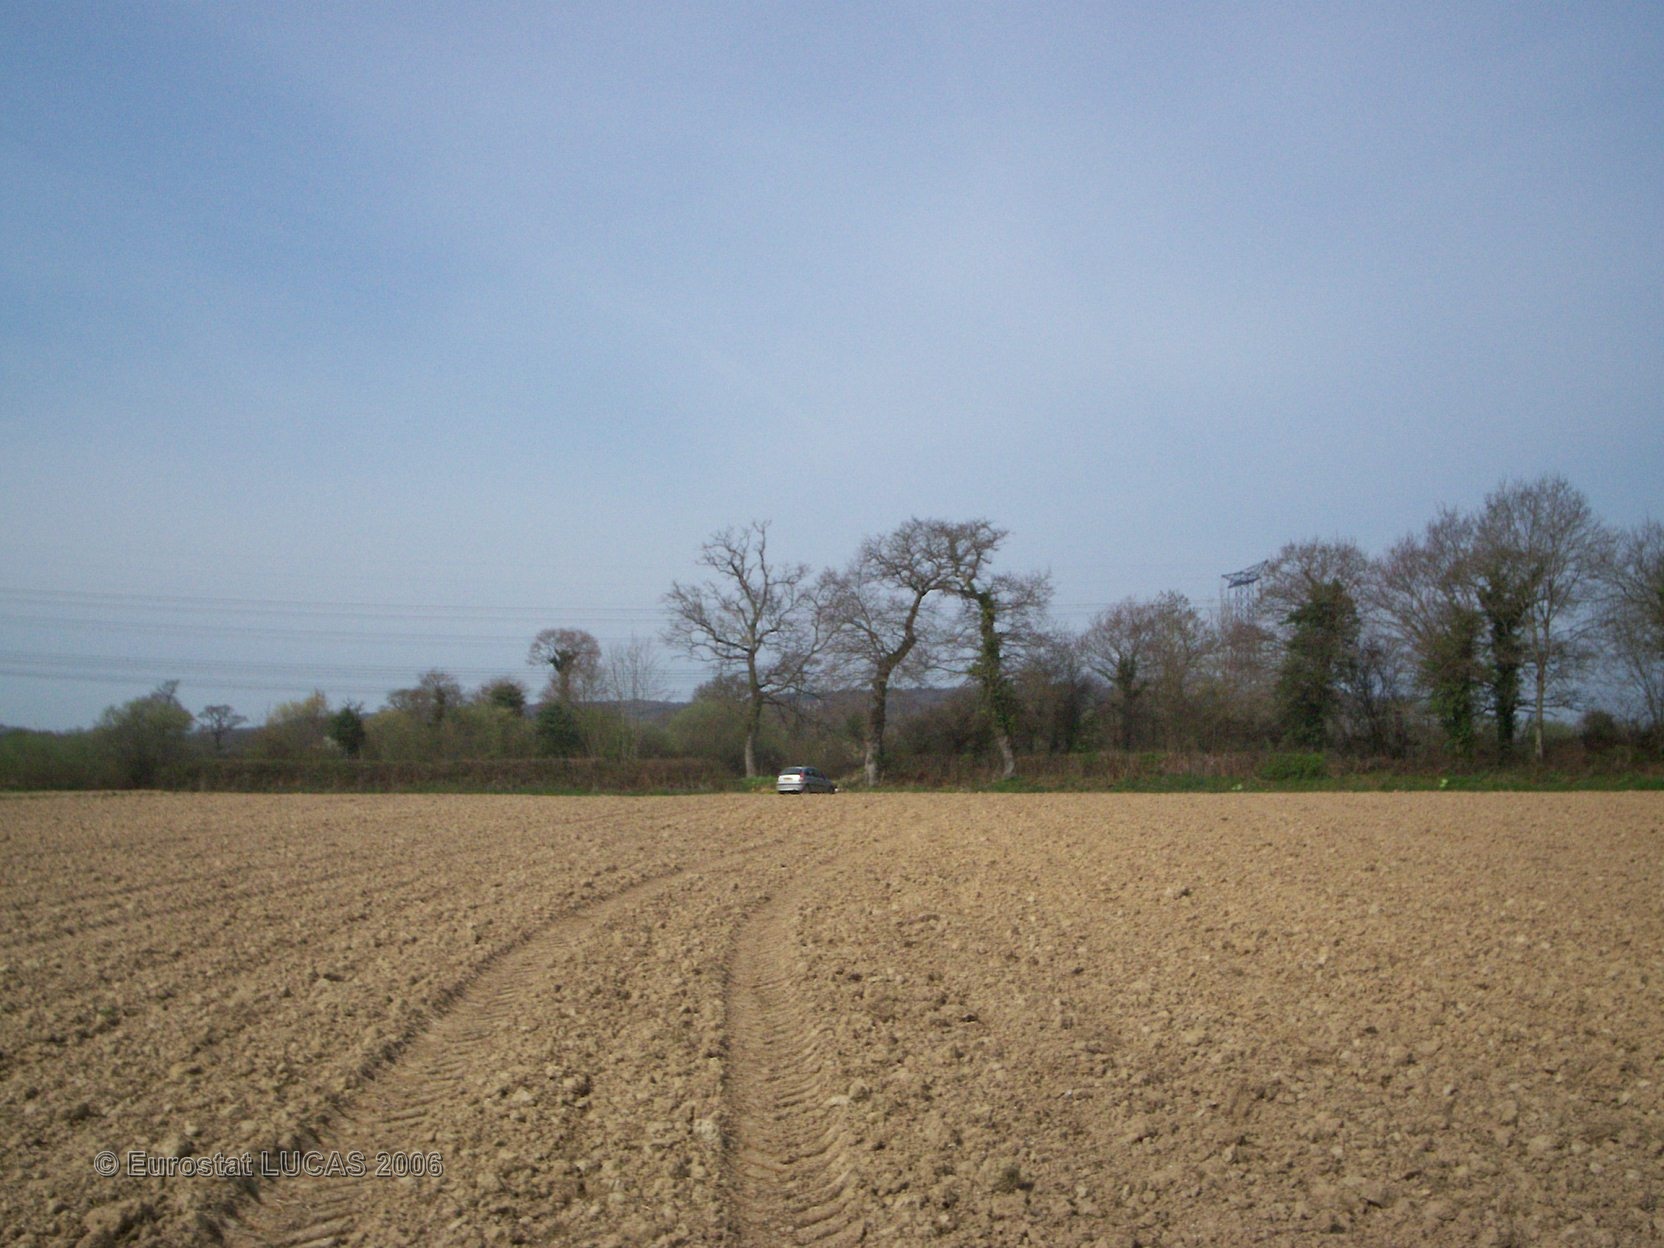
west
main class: Cropland
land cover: Barley
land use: Agriculture (excluding fallow land and kitchen gardens)
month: May
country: FR
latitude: 49.3293
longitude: -1.4835
